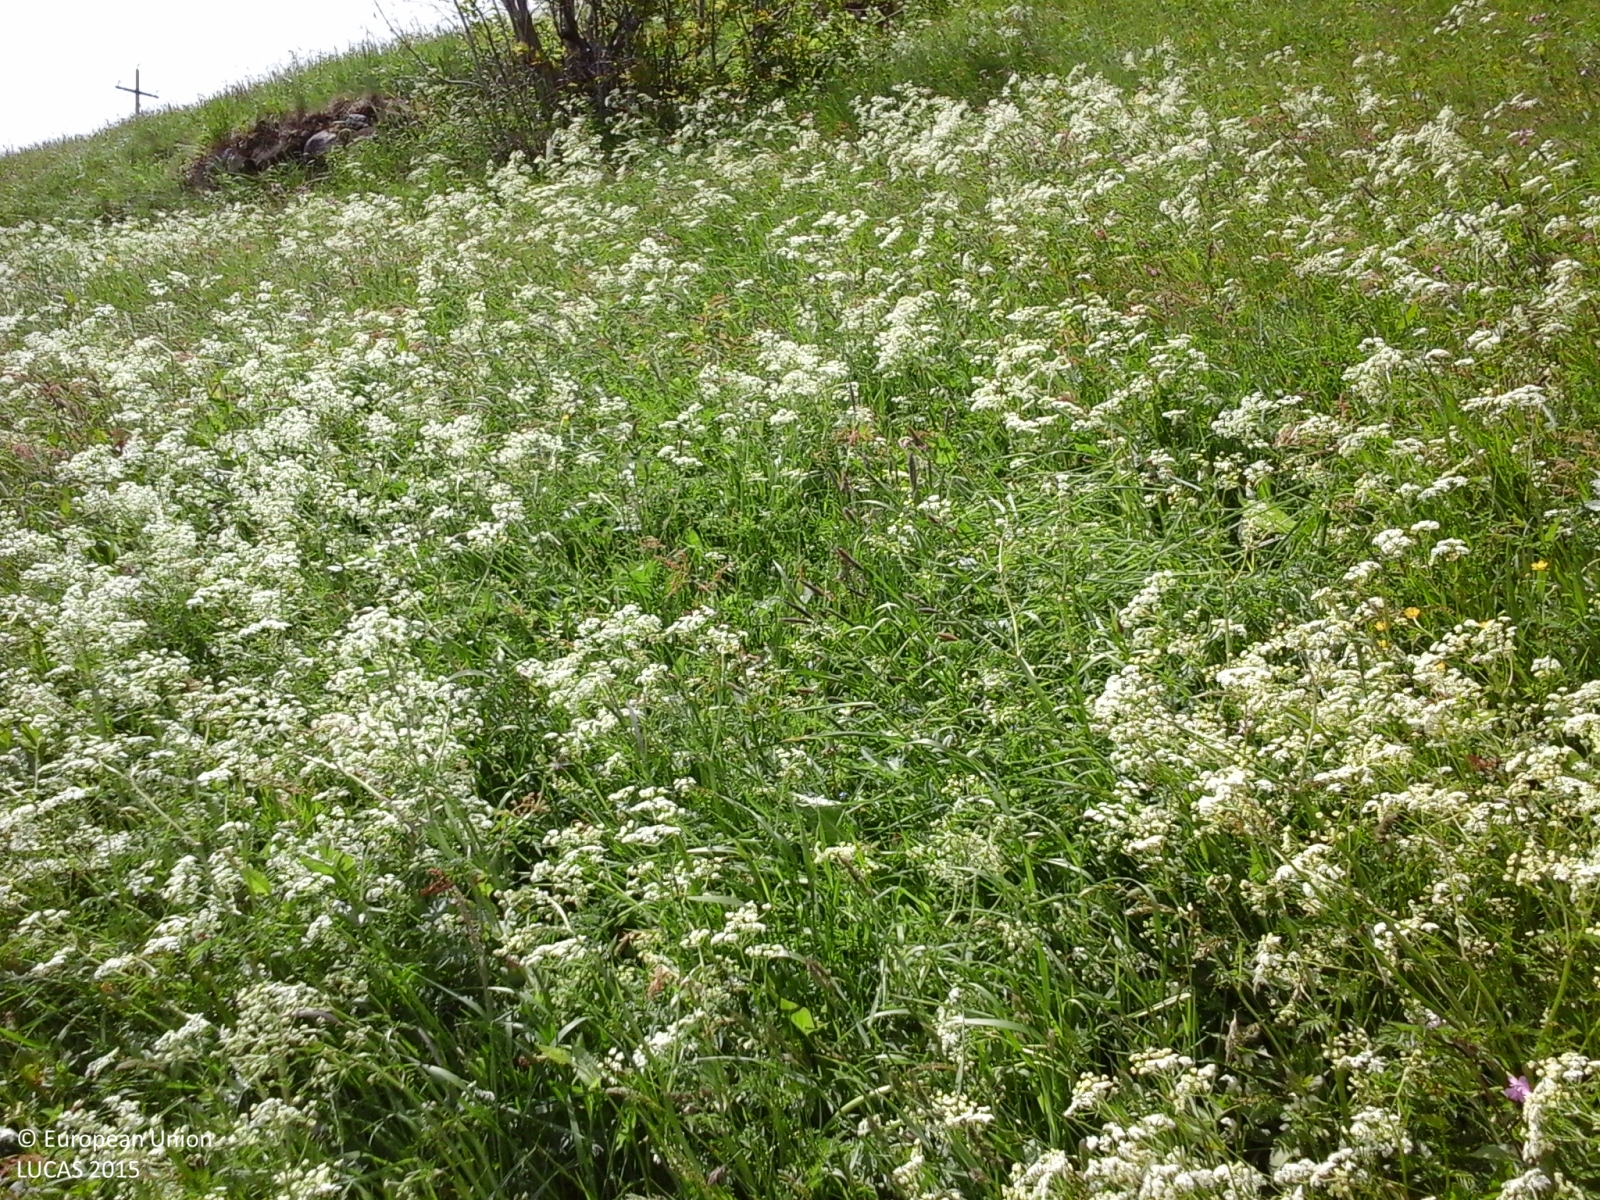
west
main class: Grassland
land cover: Grassland without tree/shrub cover
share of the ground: > 75 %
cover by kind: herbaceous plants 100 %
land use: Agriculture (excluding fallow land and kitchen gardens)
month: May
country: IT
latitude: 46.6917
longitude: 10.6138
